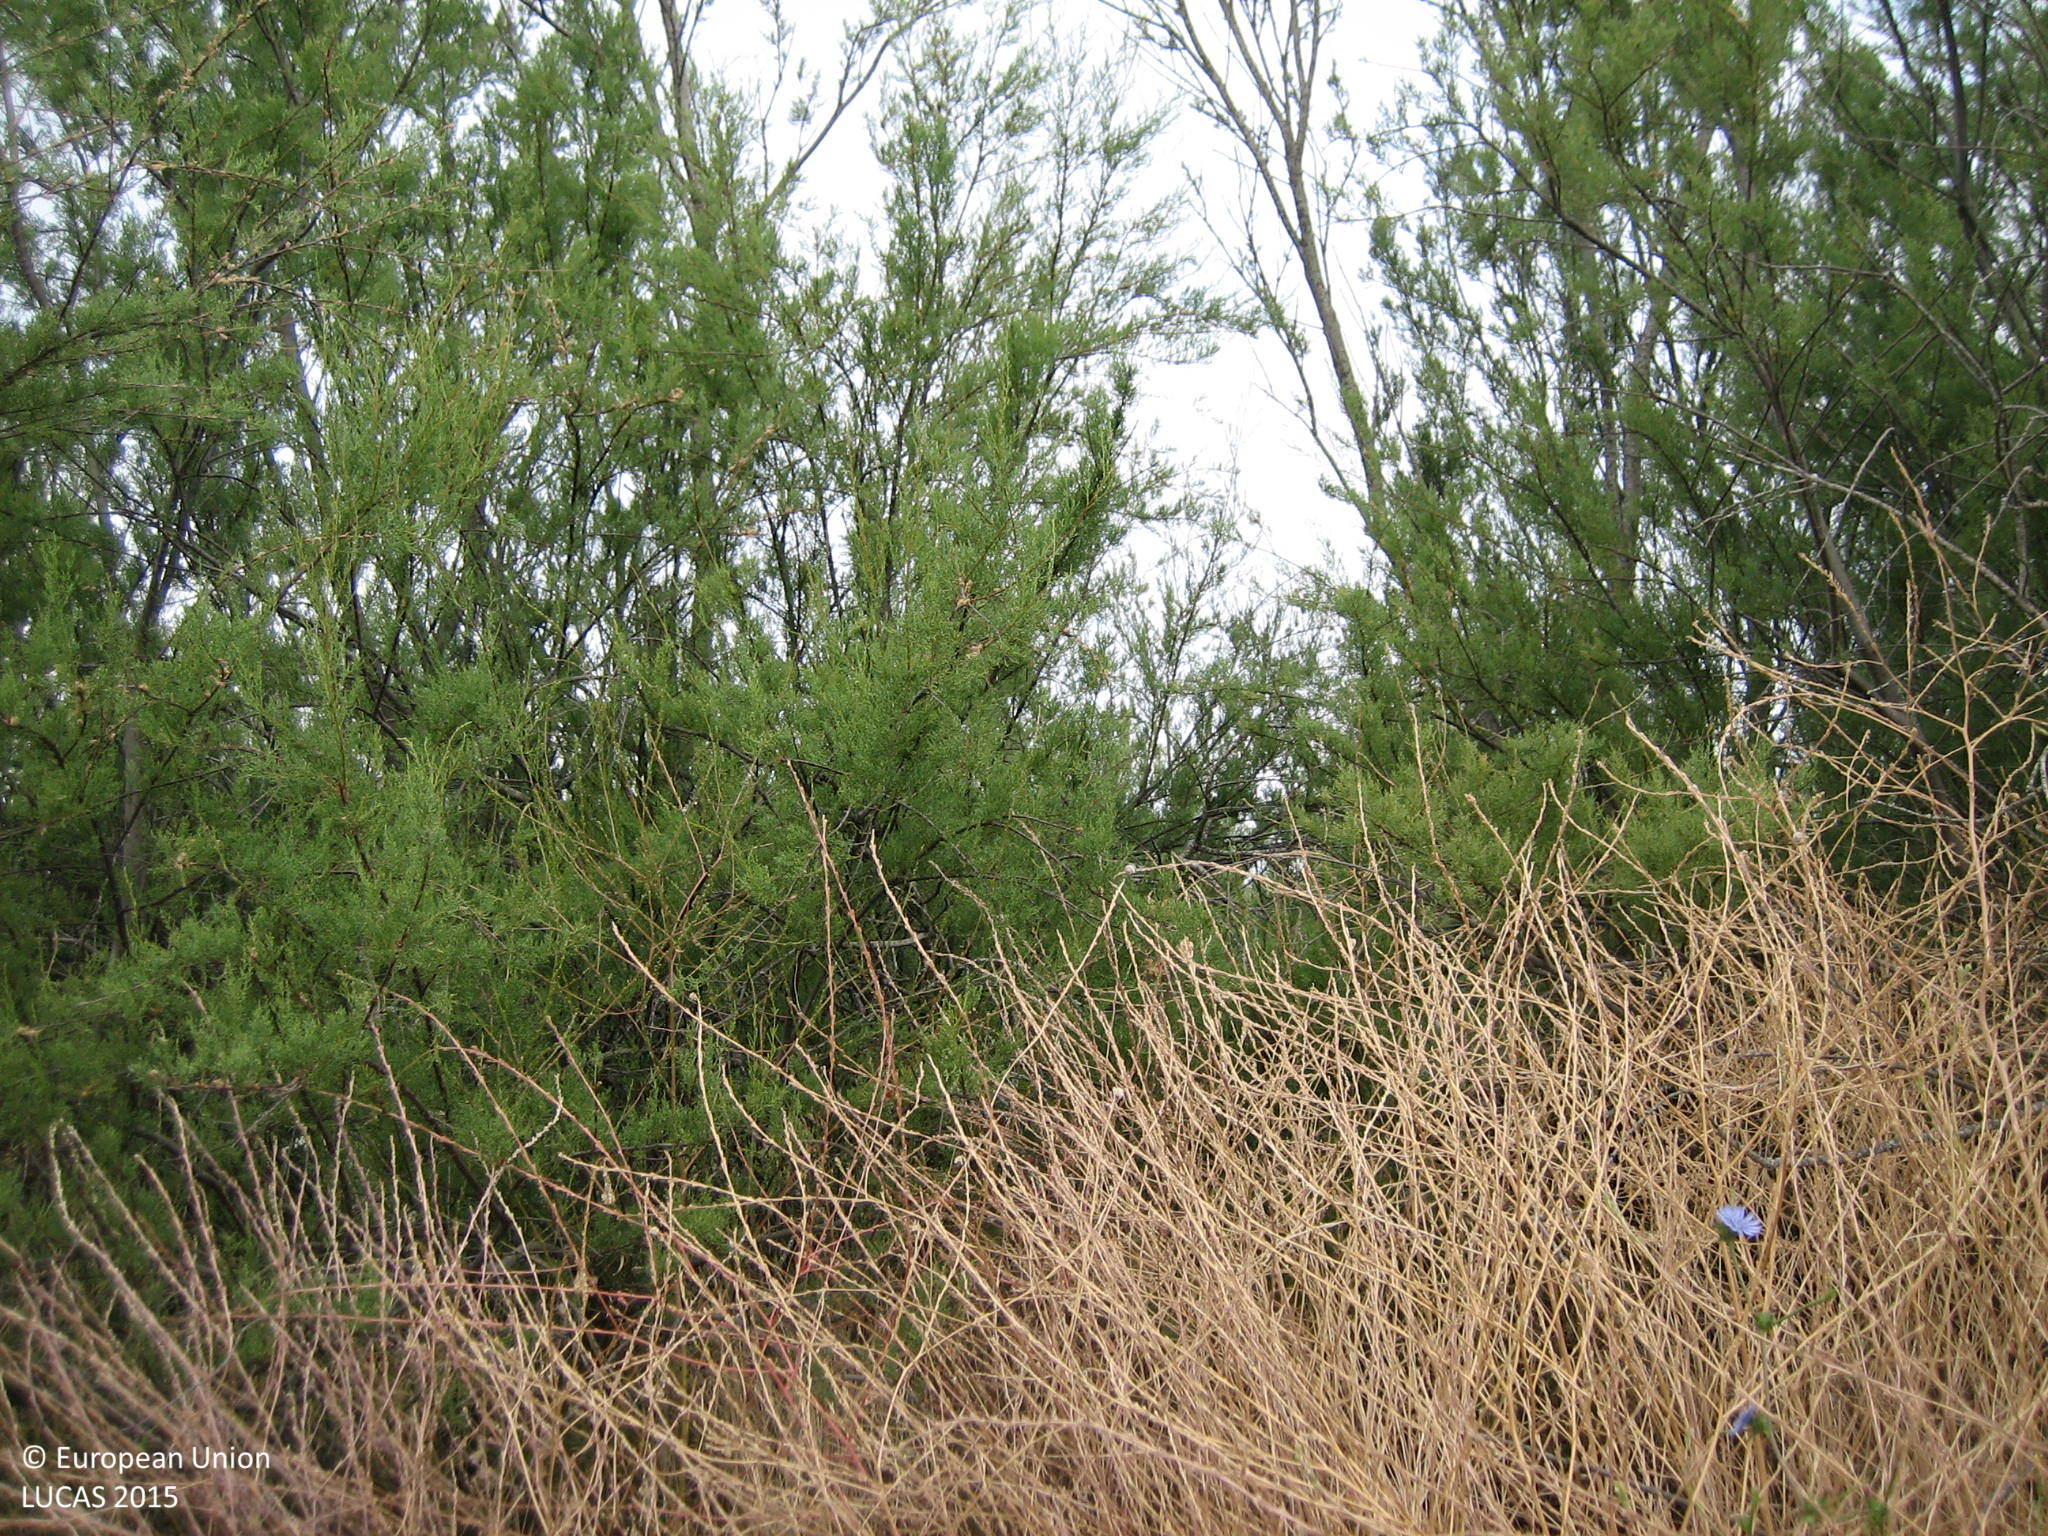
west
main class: Shrubland
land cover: Shrubland without tree cover
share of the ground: > 75 %
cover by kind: shrubs 80 %, herbaceous plants 20 %
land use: Semi-natural and natural areas not in use
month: June
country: ES
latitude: 39.0970
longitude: -4.5882
